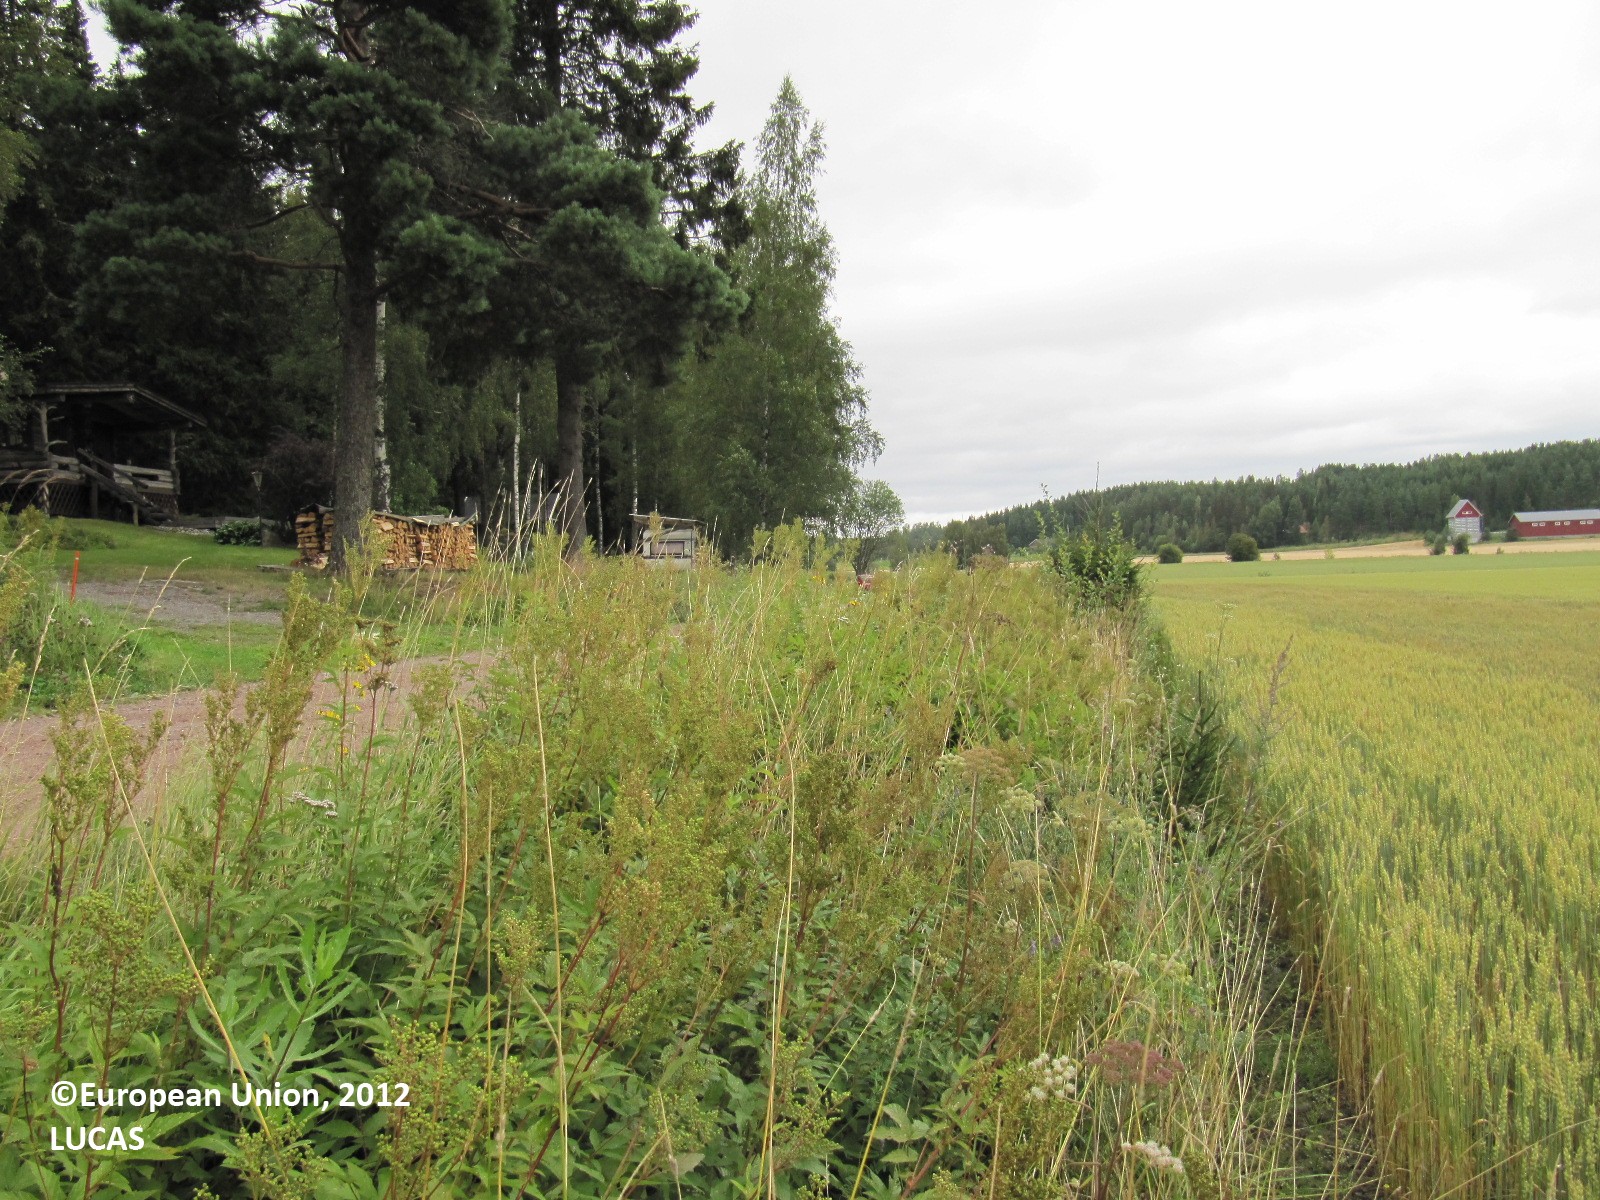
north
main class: Cropland
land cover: Common wheat
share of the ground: > 75 %
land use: Agriculture (excluding fallow land and kitchen gardens)
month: August
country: FI
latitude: 60.1575
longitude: 23.0343
